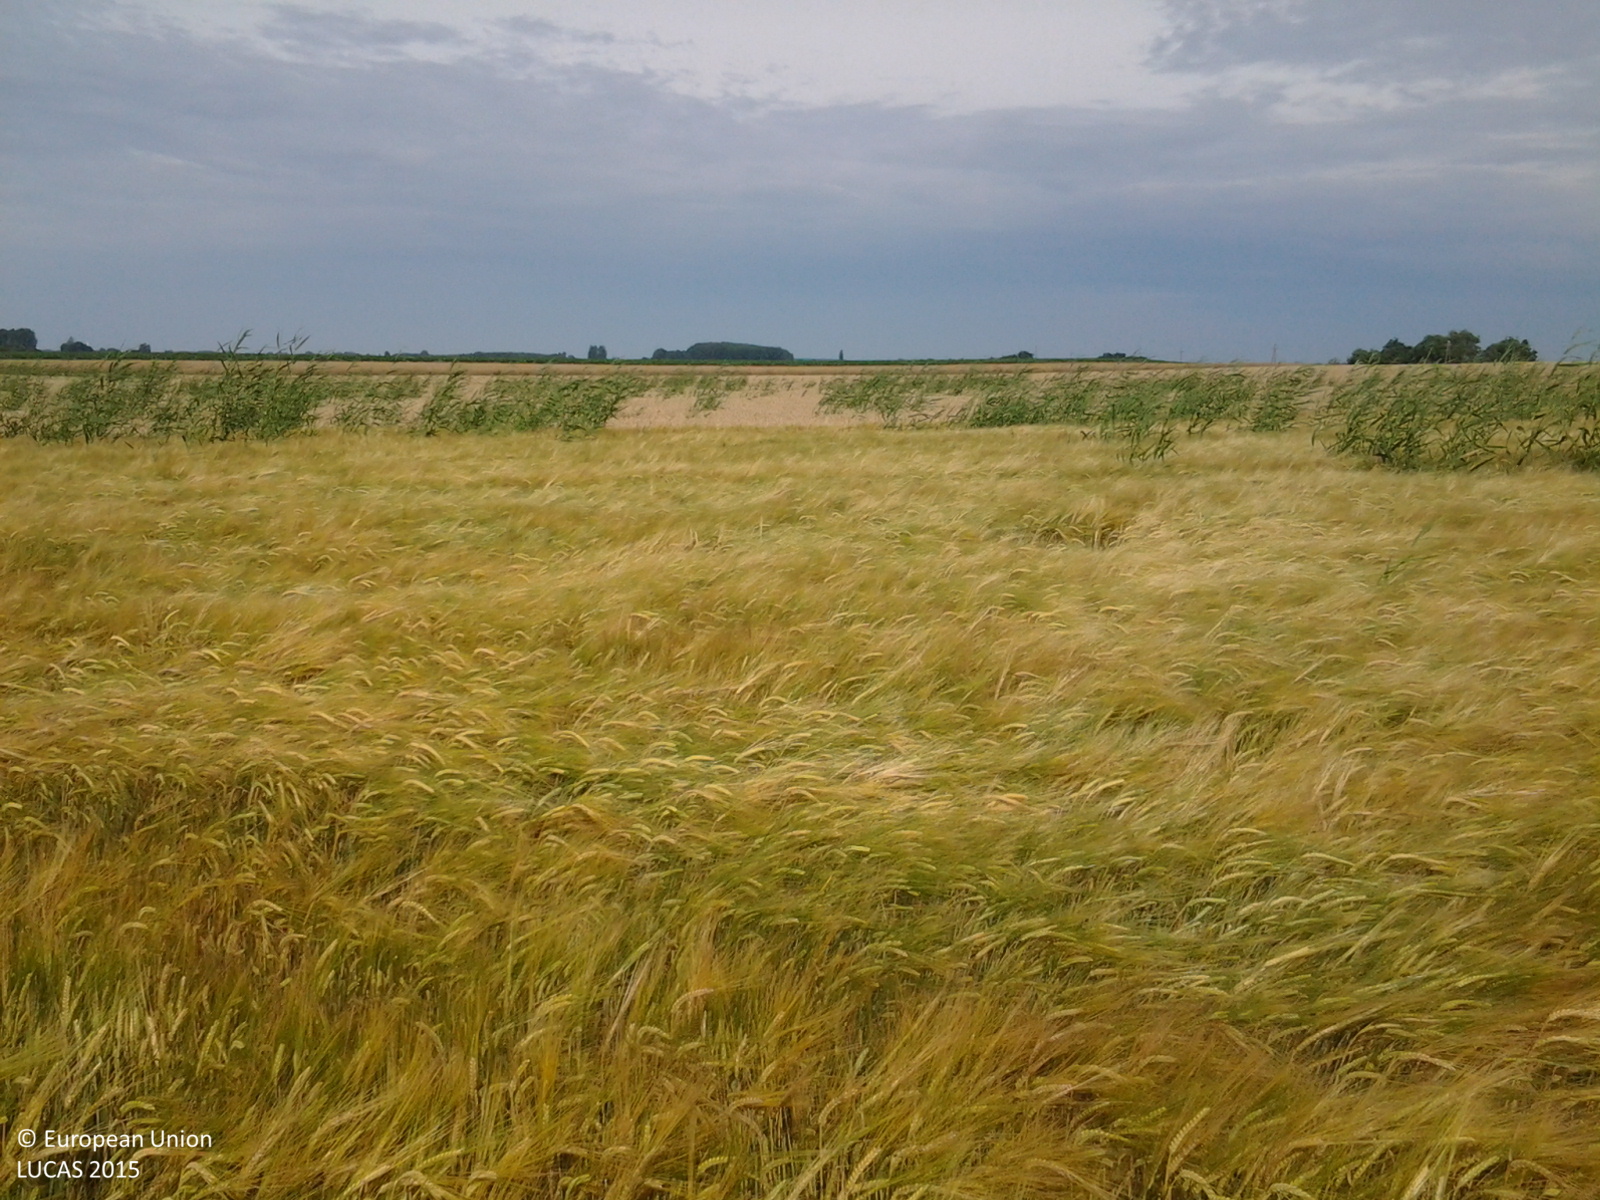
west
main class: Cropland
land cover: Barley
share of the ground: > 75 %
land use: Agriculture (excluding fallow land and kitchen gardens)
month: June
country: HU
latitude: 46.4731
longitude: 21.1691
